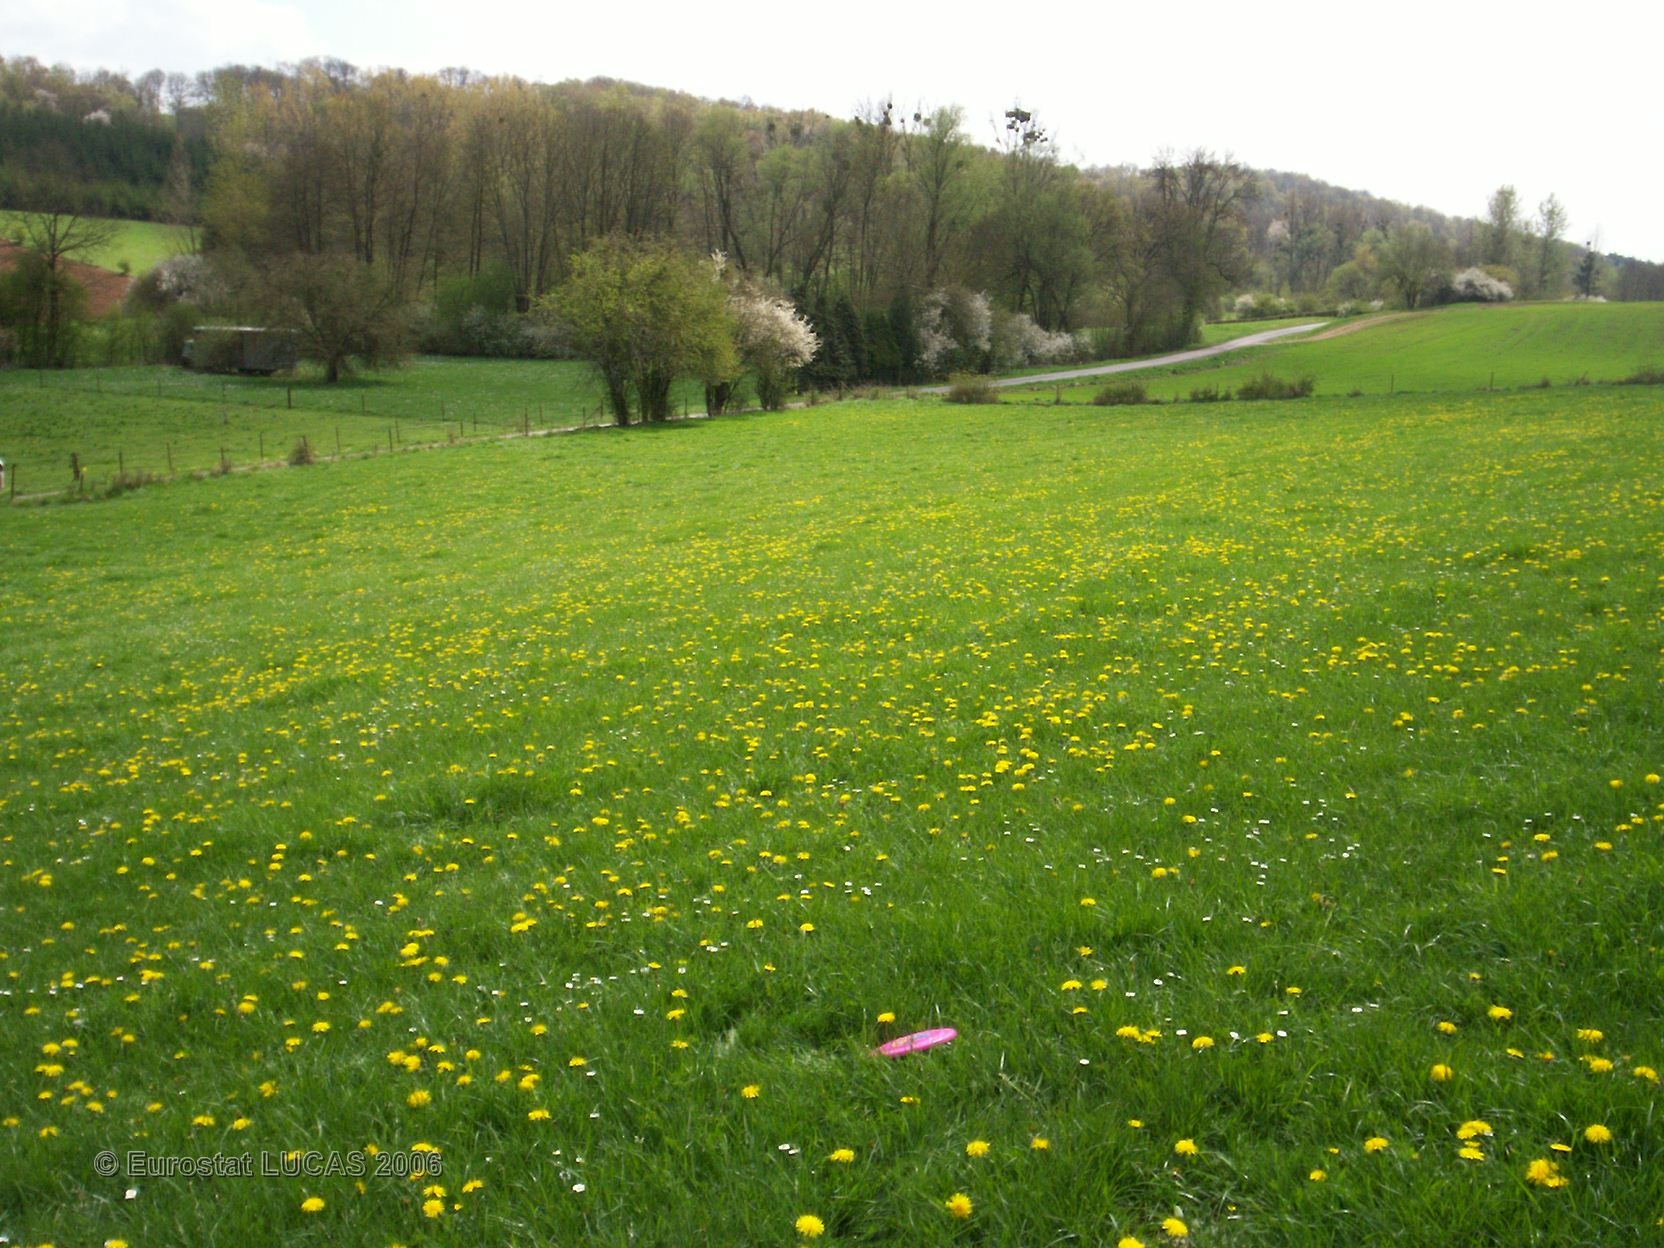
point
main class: Grassland
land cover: Grassland without tree/shrub cover
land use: Agriculture (excluding fallow land and kitchen gardens)
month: May
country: FR
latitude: 49.7942
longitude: 4.3974
